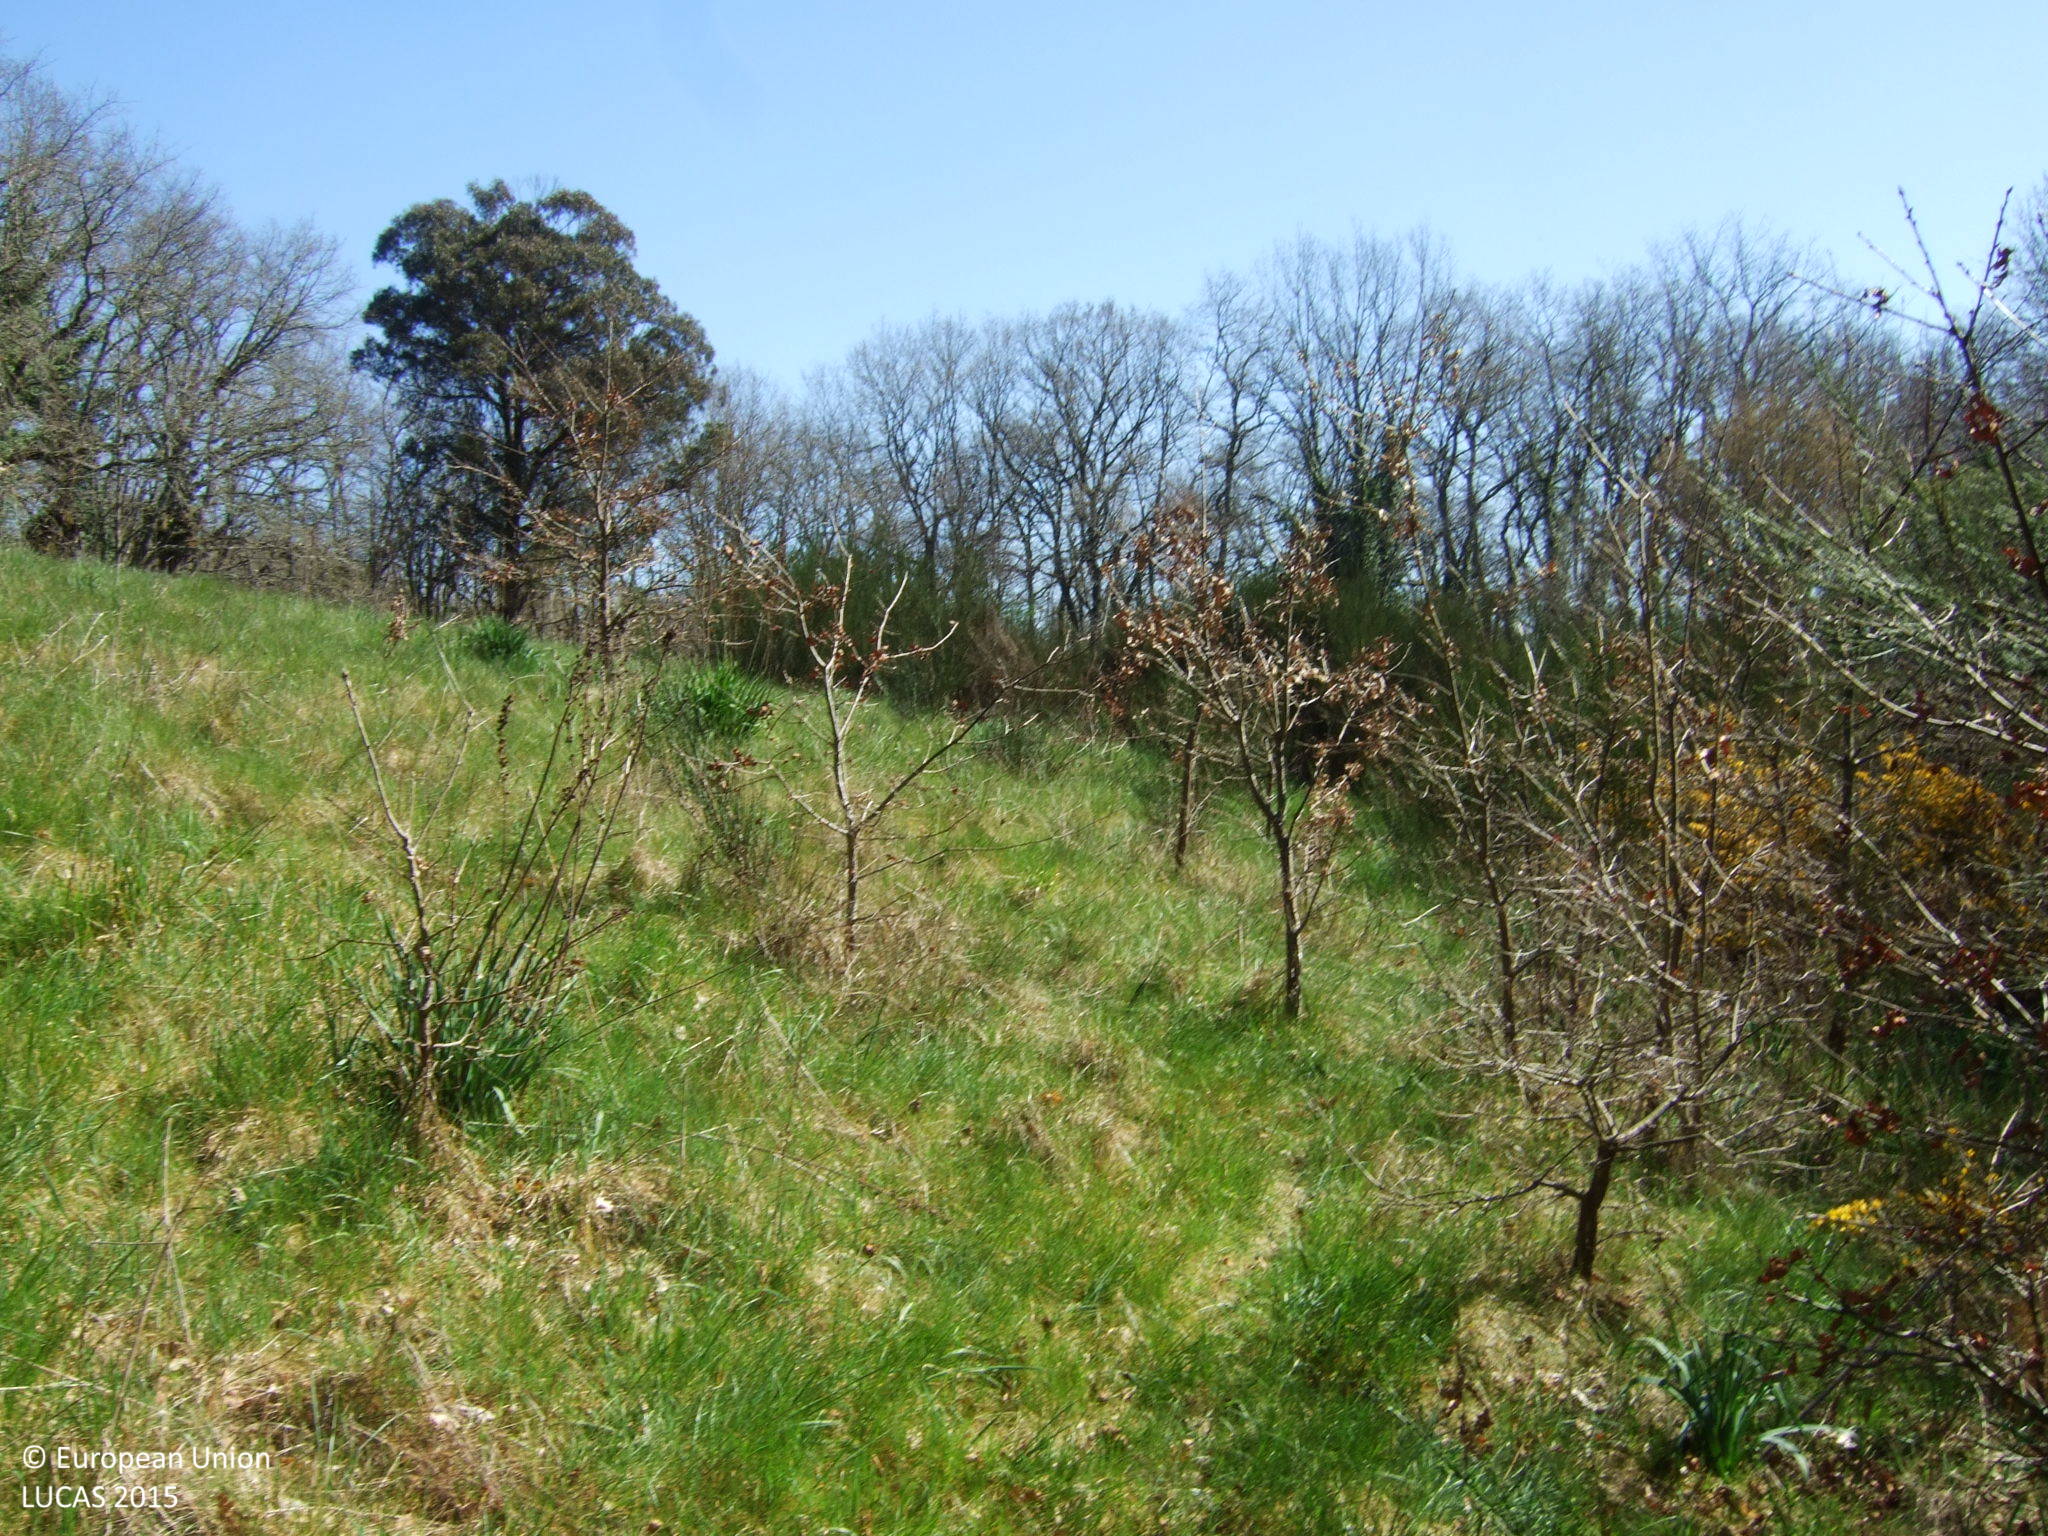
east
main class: Shrubland
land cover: Shrubland with sparse tree cover
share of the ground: > 75 %
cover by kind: shrubs 75 %, herbaceous plants 20 %, broadleaved forest trees 5 %
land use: Semi-natural and natural areas not in use
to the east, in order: Shrubland with sparse tree cover; Broadleaved woodland; Tracks; Broadleaved woodland
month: April
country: ES
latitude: 42.7050
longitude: -7.7946
